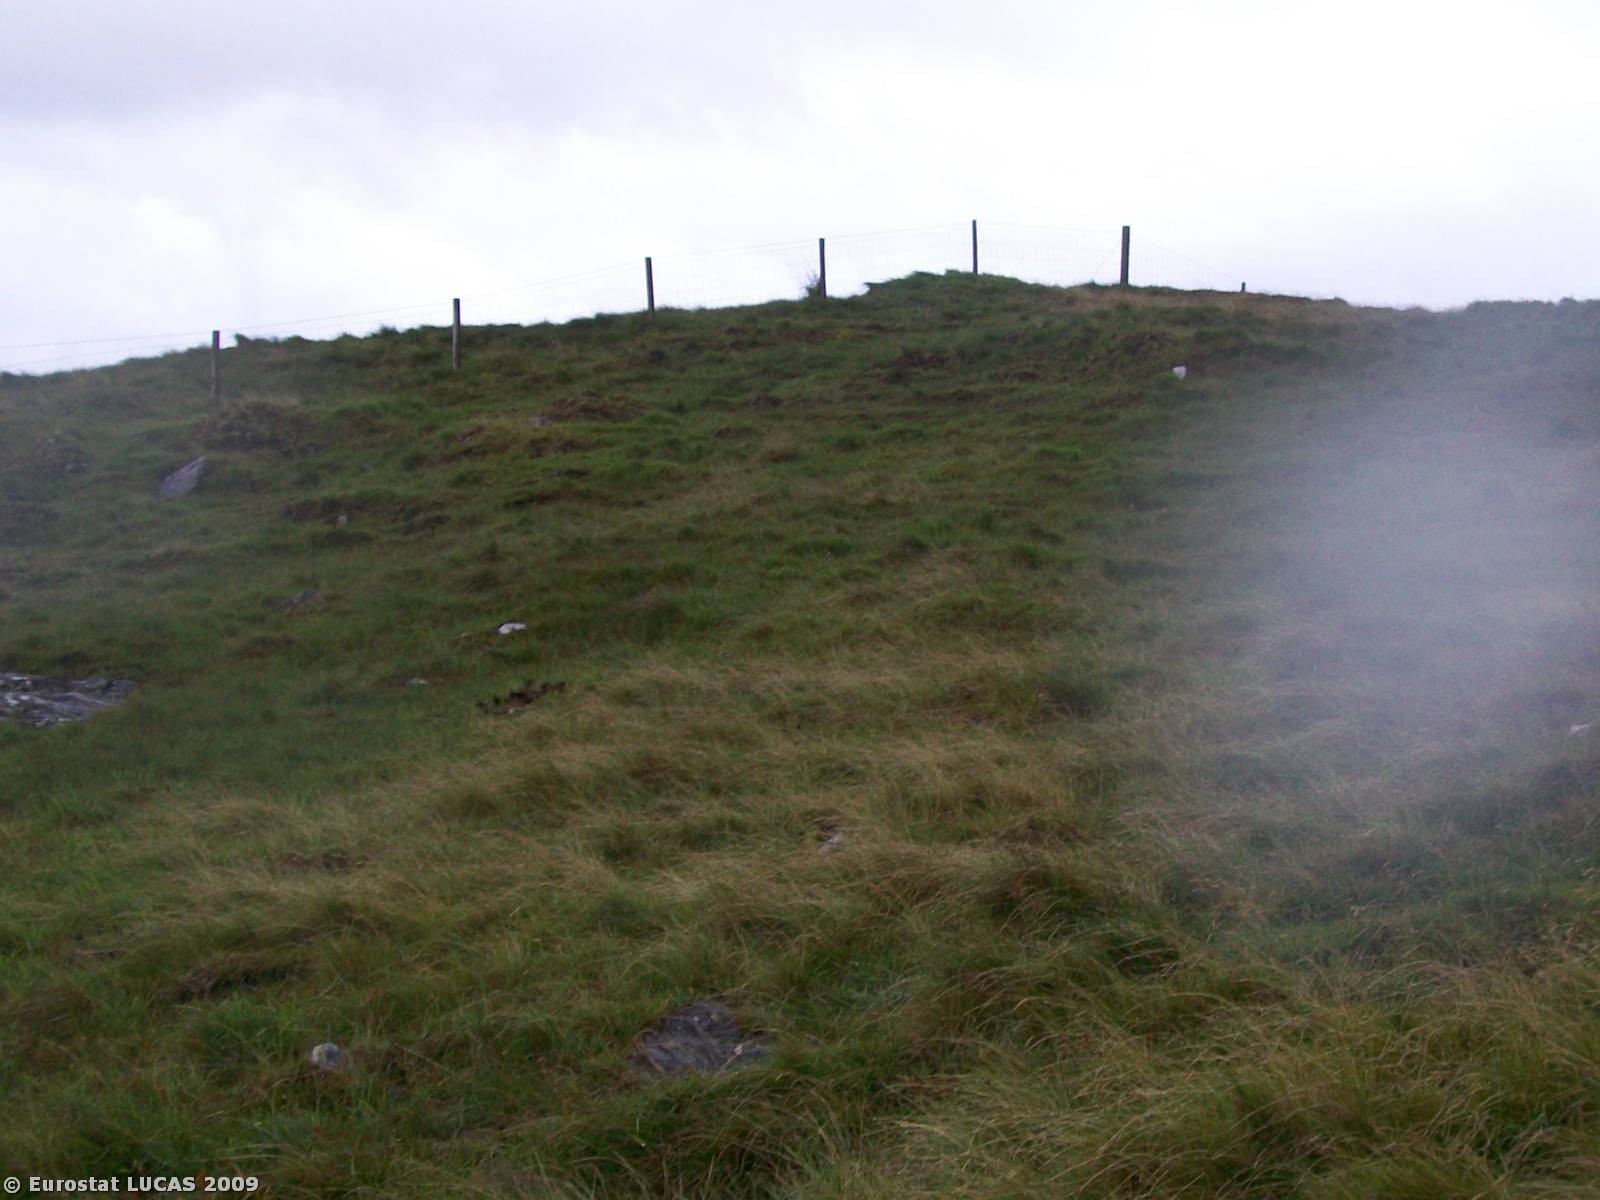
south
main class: Grassland
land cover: Grassland without tree/shrub cover
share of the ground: > 75 %
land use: Agriculture (excluding fallow land and kitchen gardens)
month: July
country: IE
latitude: 53.5405
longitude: -9.4708
